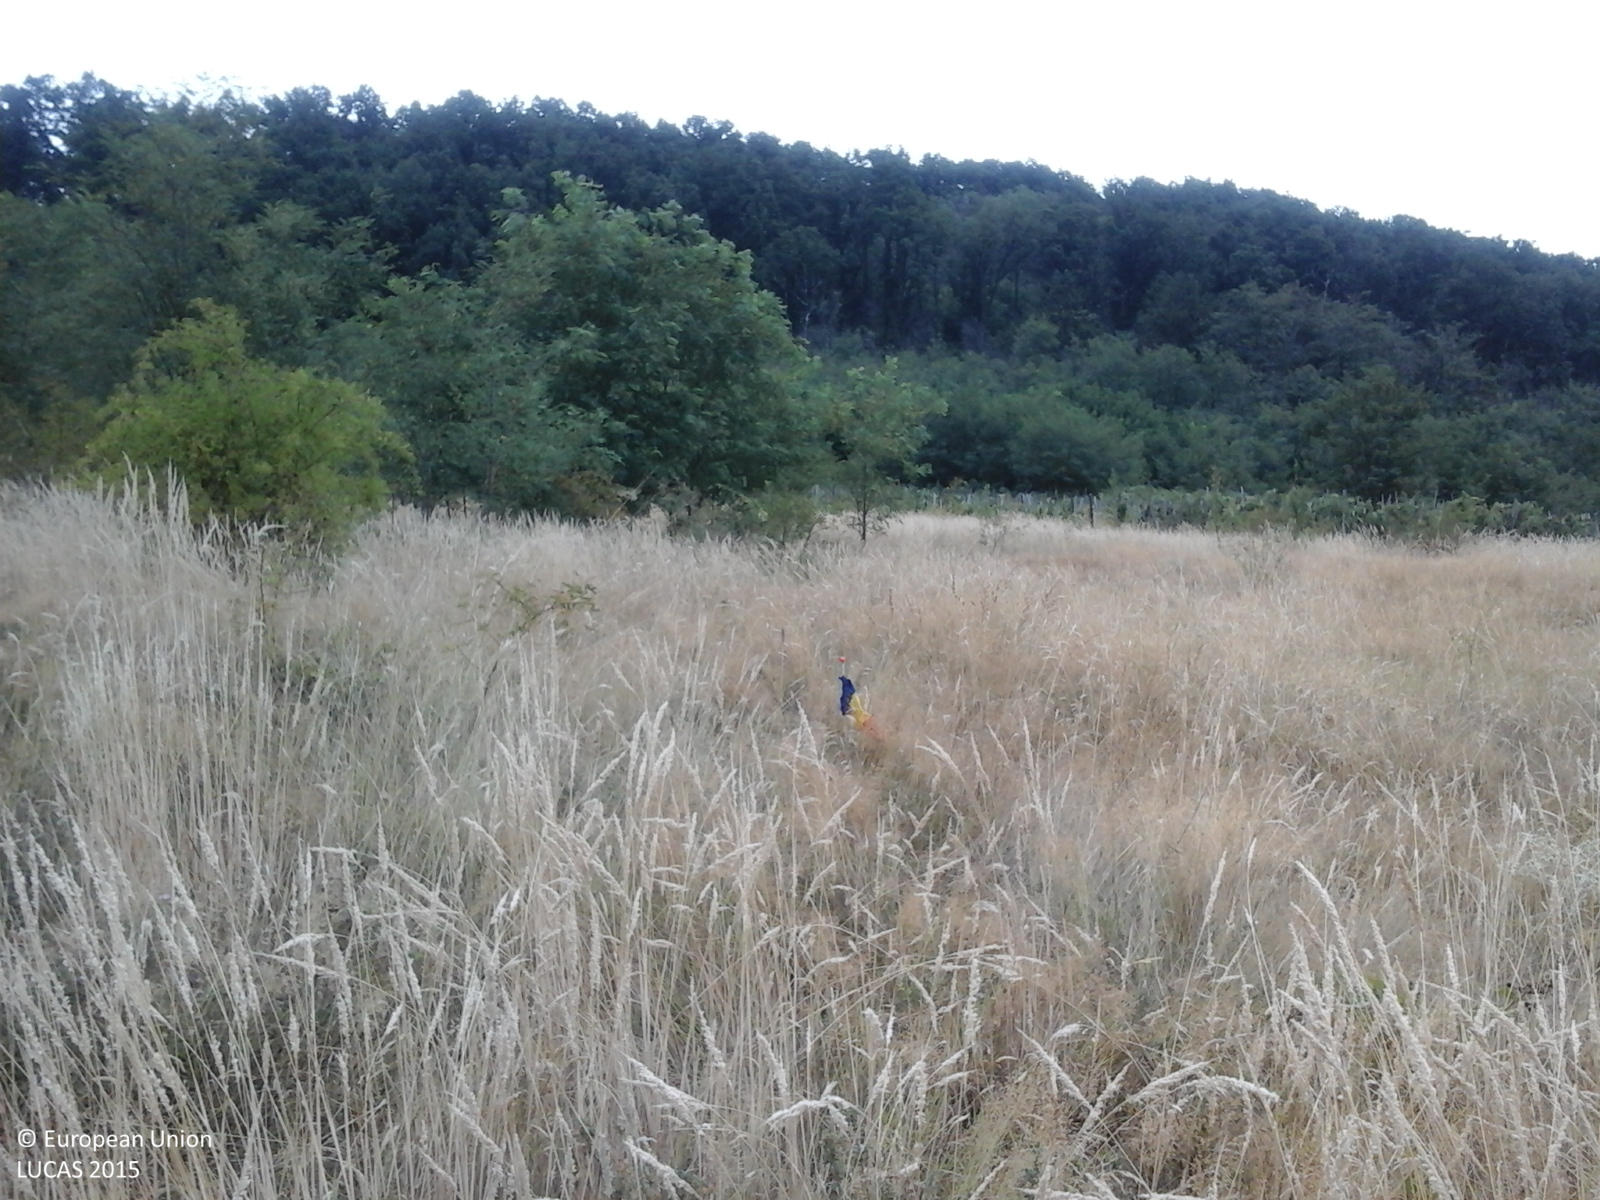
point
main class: Grassland
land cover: Grassland with sparse tree/shrub cover
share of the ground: > 75 %
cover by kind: herbaceous plants 85 %, shrubs 10 %, broadleaved forest trees 5 %
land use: Fallow land
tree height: < 5 m
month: August
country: RO
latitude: 44.7591
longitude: 22.7911
